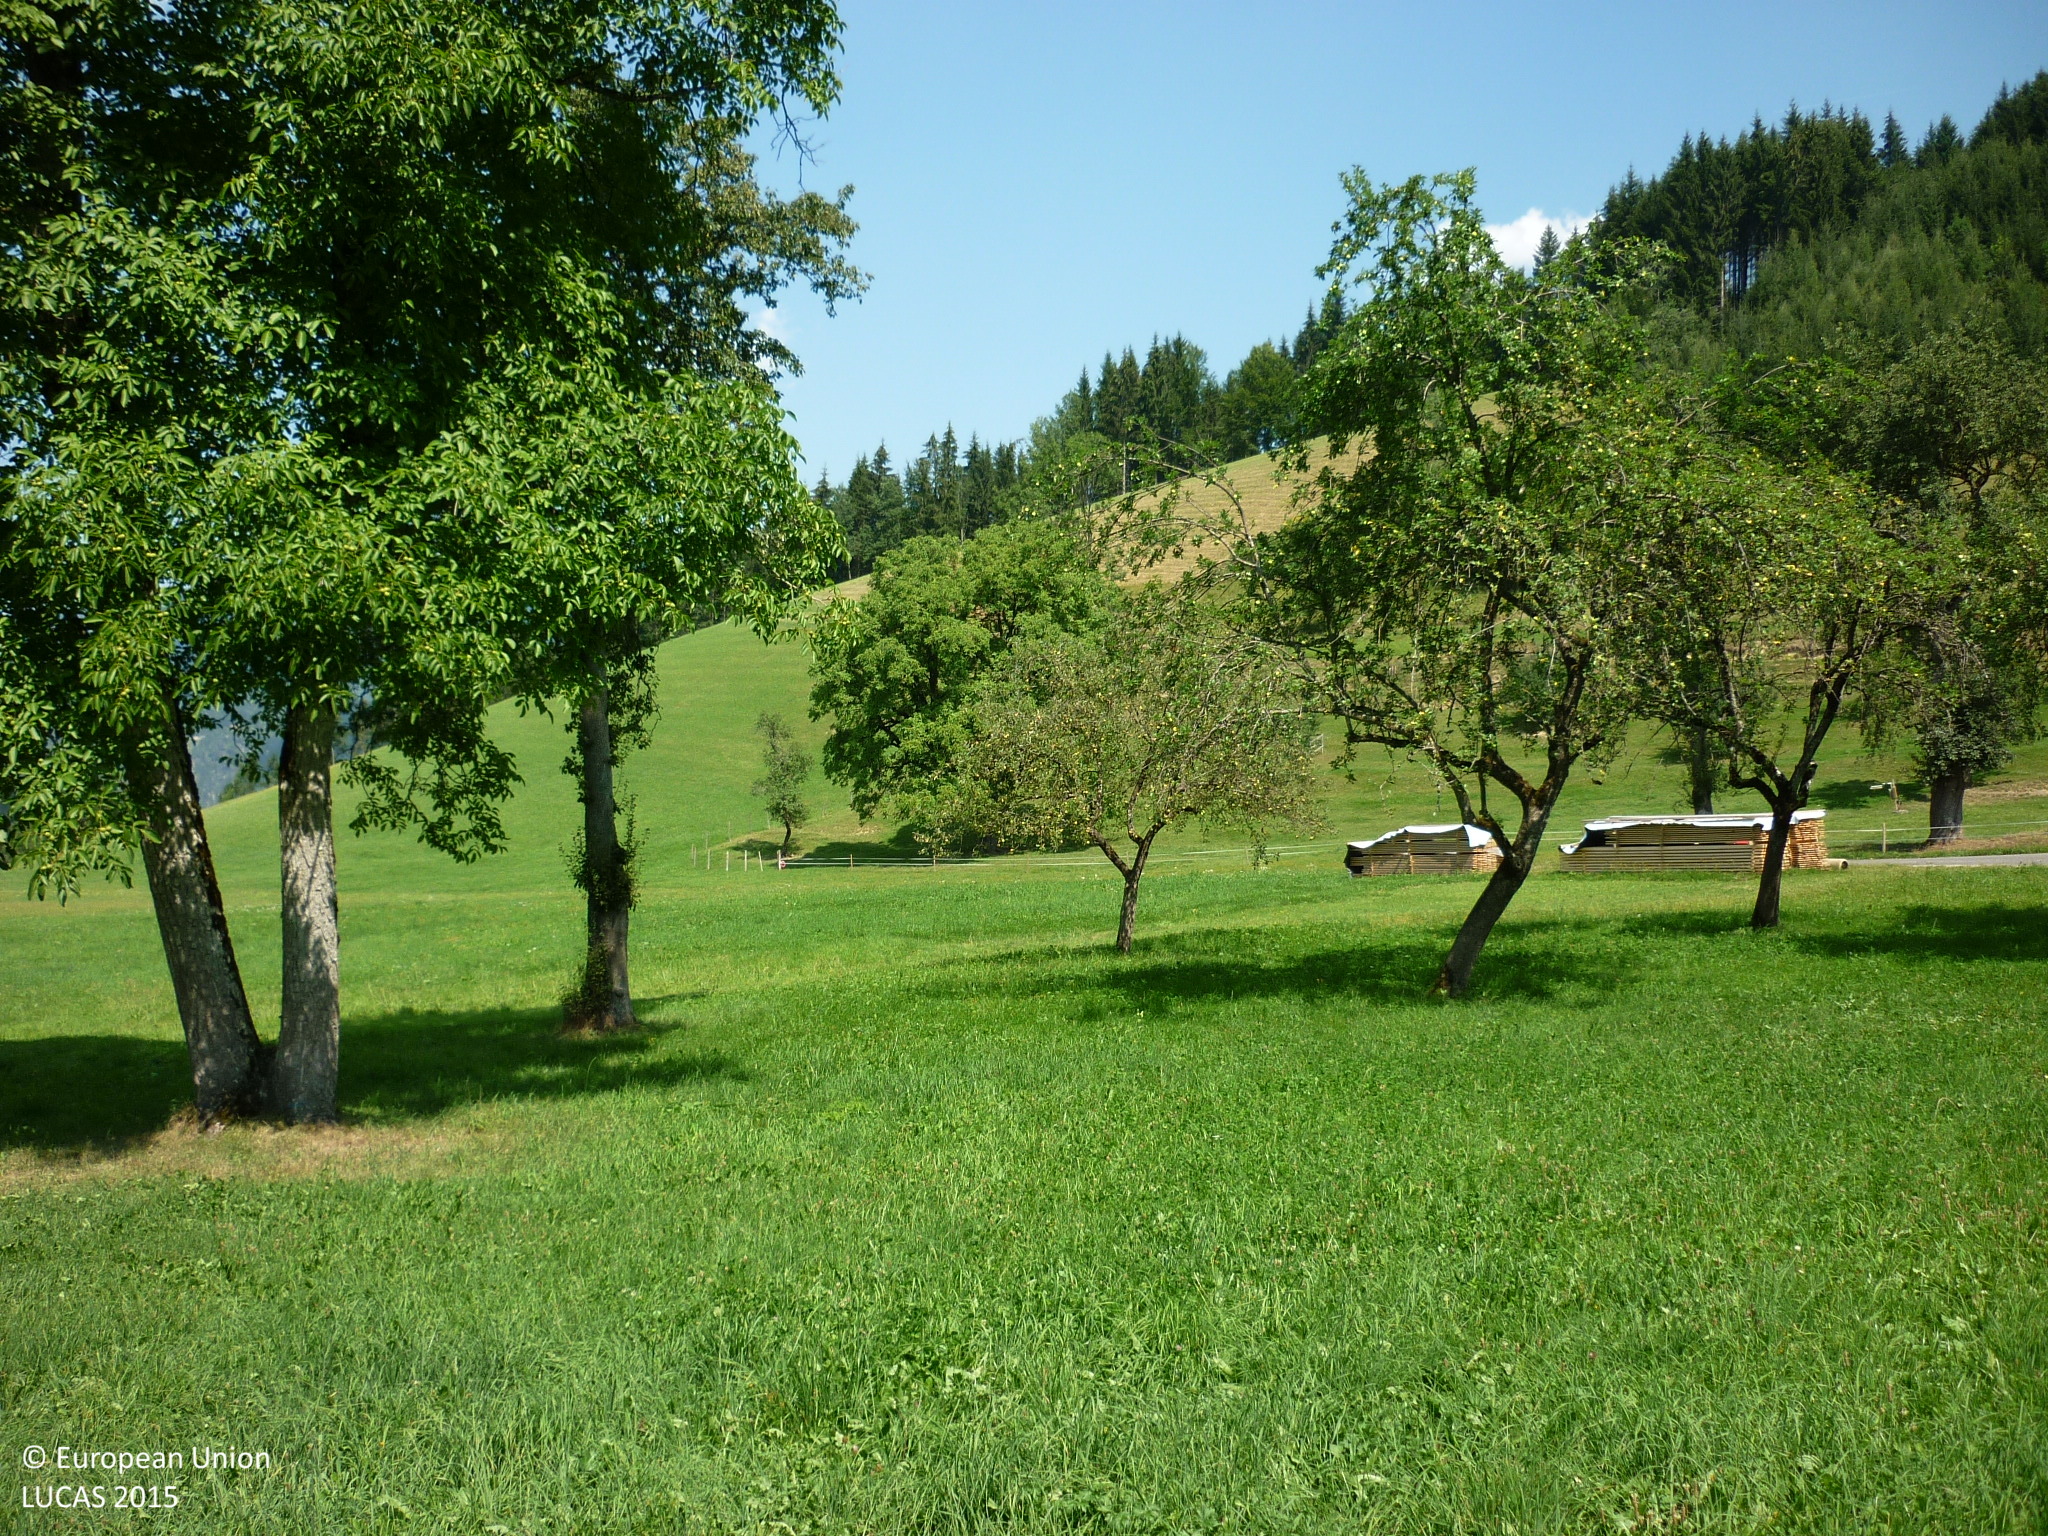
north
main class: Grassland
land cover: Grassland without tree/shrub cover
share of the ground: > 75 %
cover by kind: herbaceous plants 100 %
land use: Agriculture (excluding fallow land and kitchen gardens)
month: August
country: AT
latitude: 47.7260
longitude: 14.2790
